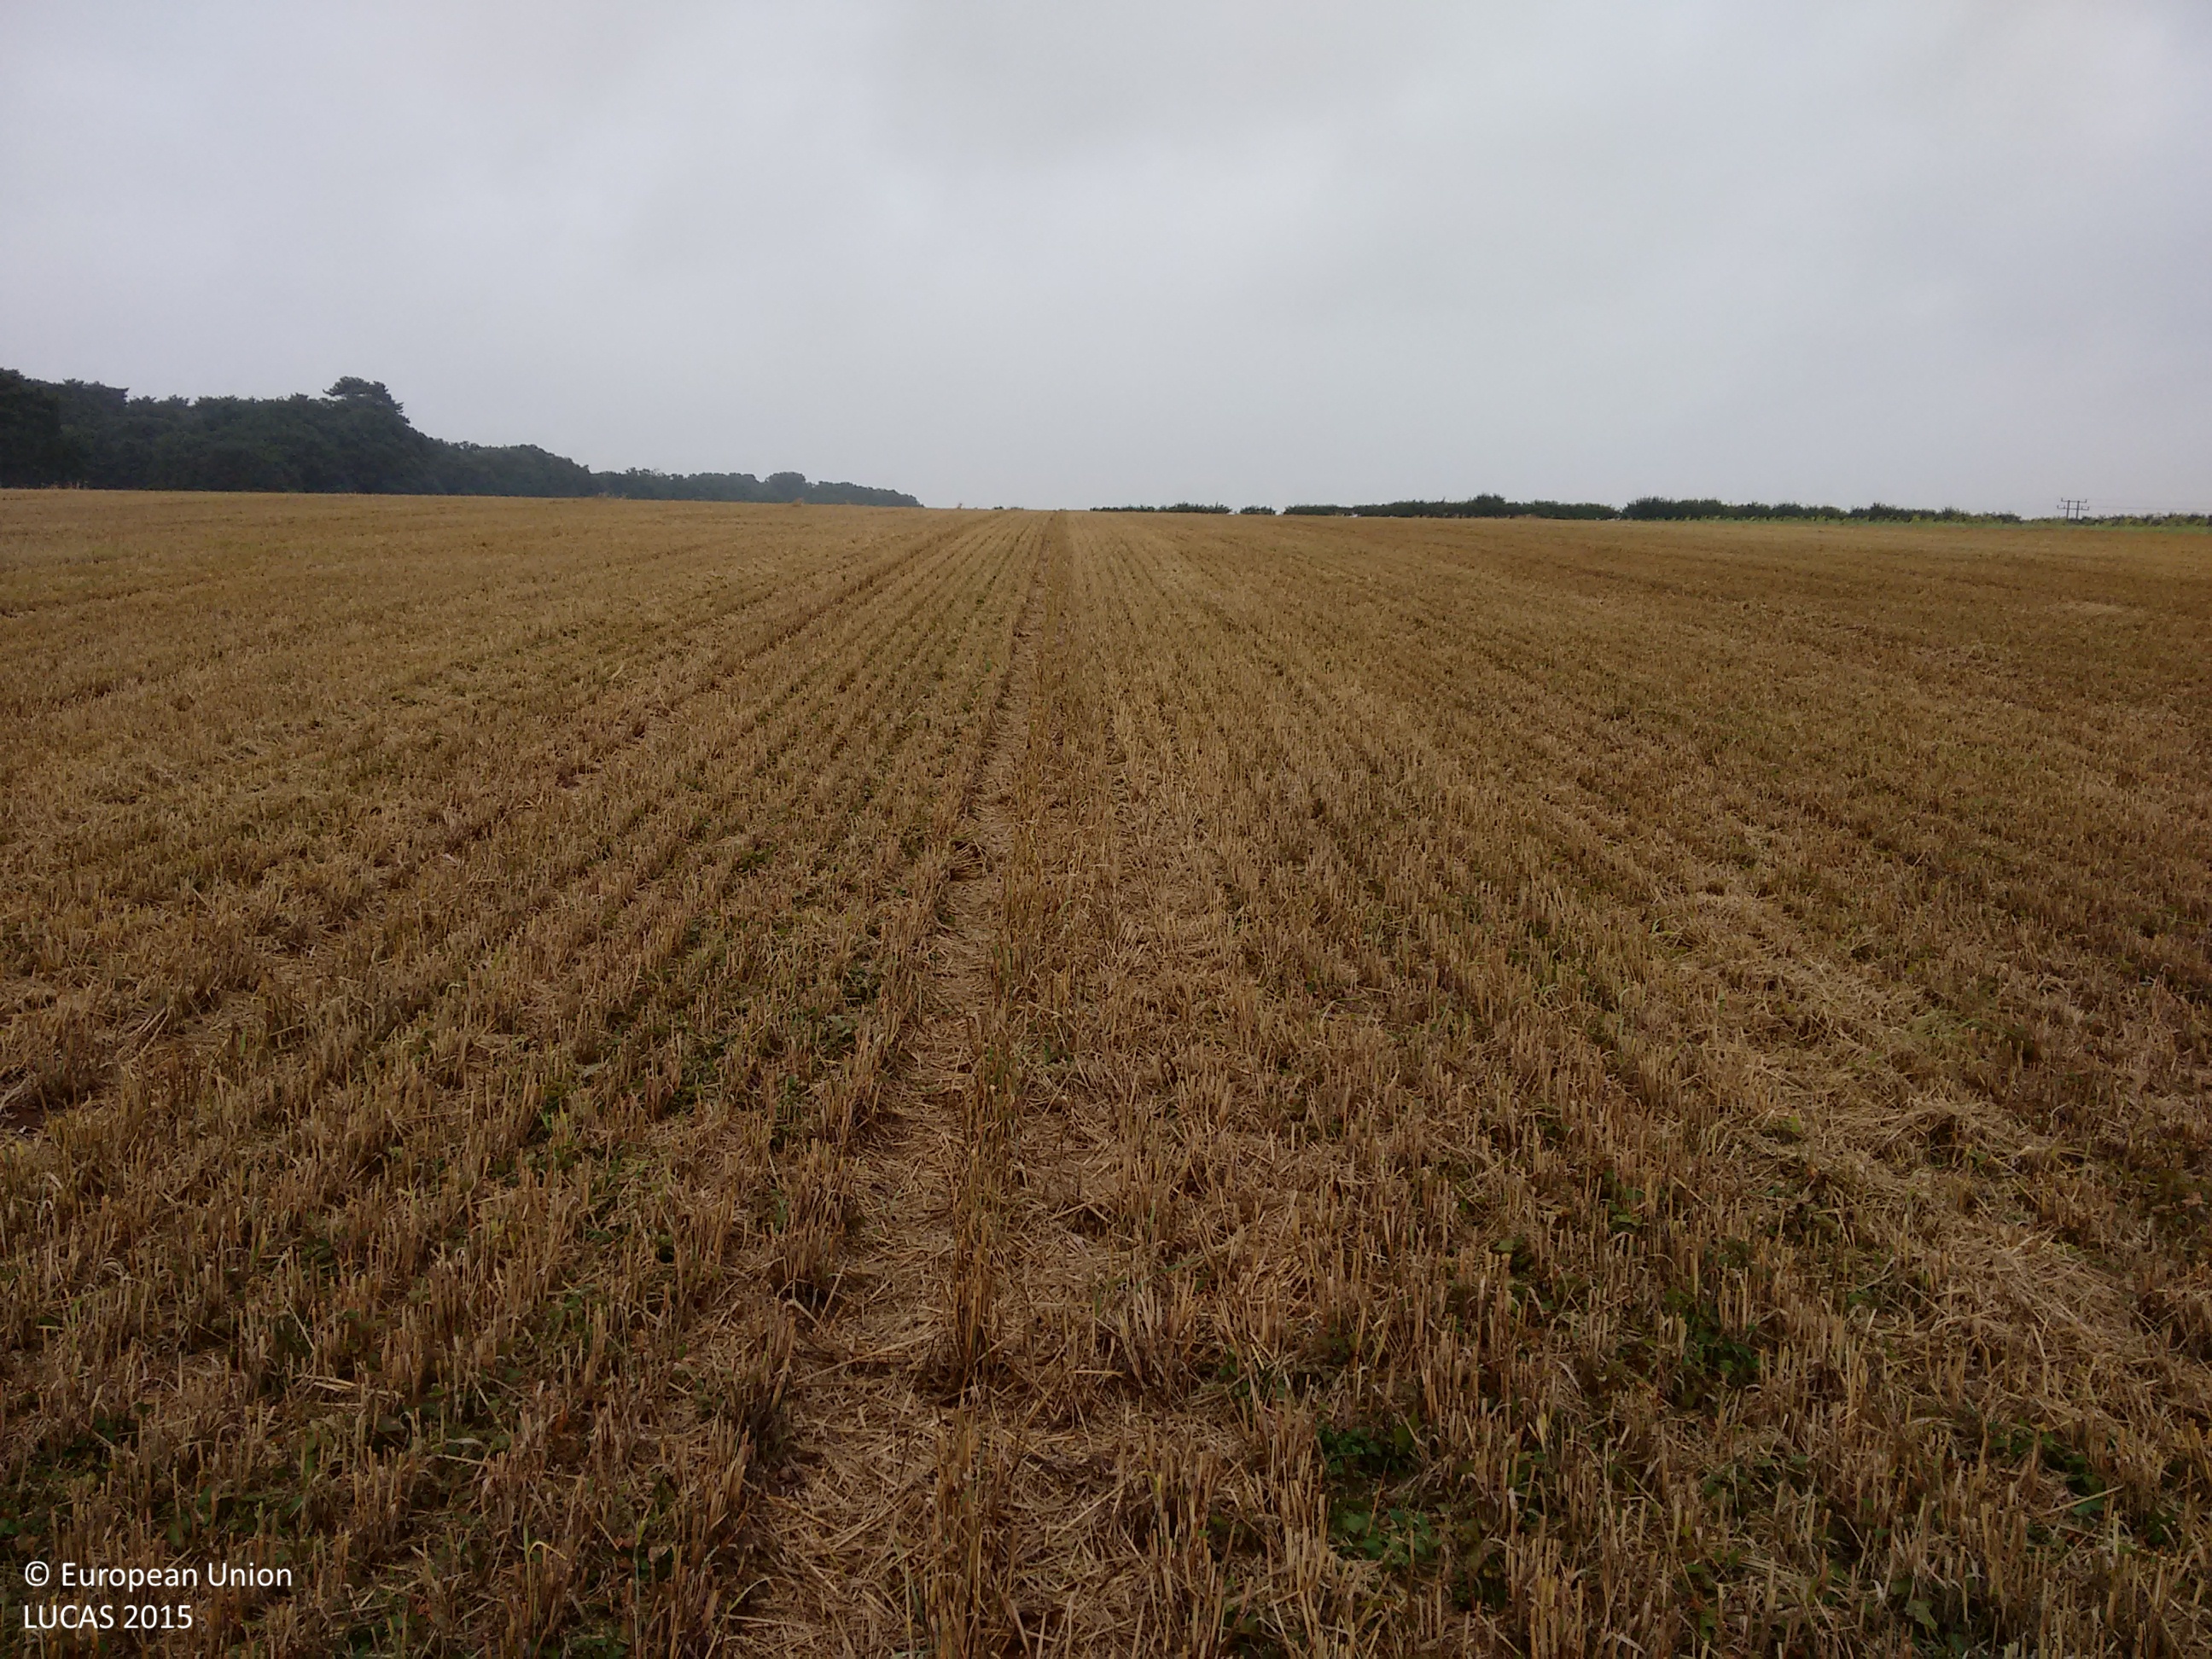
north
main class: Cropland
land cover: Common wheat
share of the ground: > 75 %
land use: Agriculture (excluding fallow land and kitchen gardens)
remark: Harvested field
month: August
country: GB
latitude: 52.9220
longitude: 0.7684
